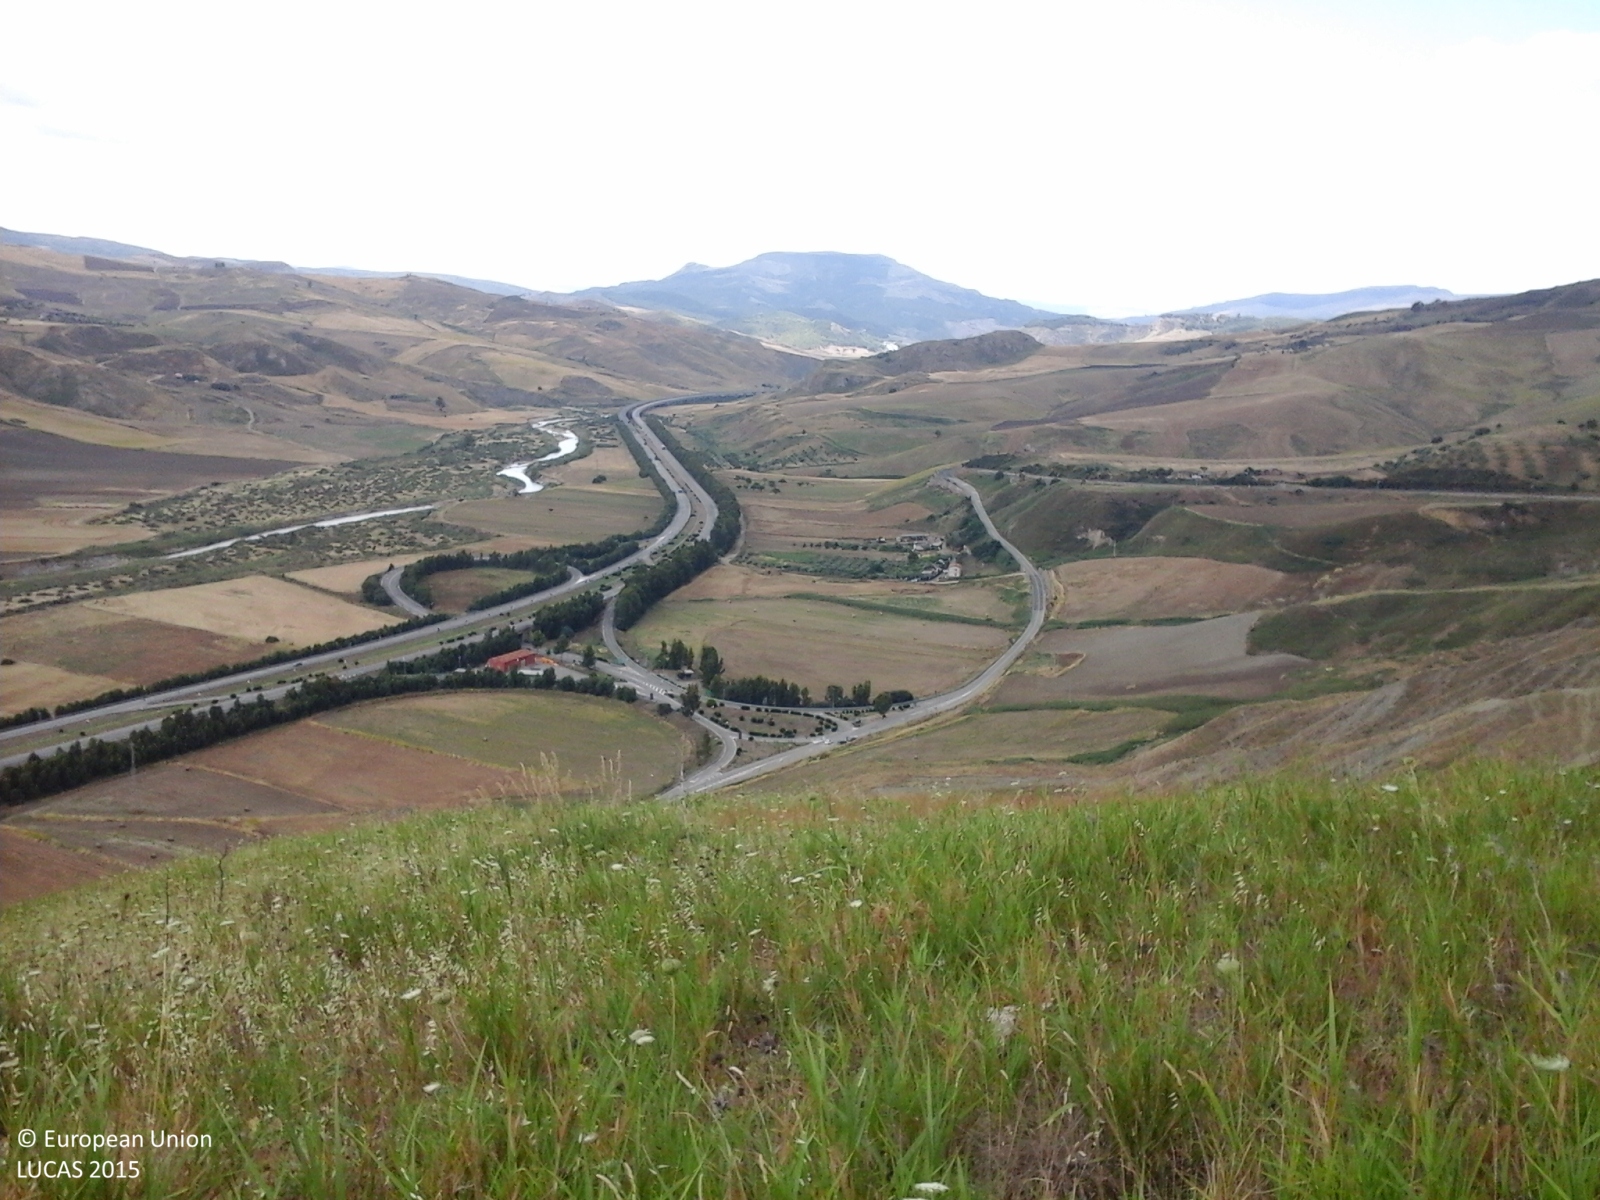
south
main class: Grassland
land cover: Grassland without tree/shrub cover
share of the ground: > 75 %
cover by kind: herbaceous plants 70 %, consolidated bare surface 20 %, unconsolidated bare surface 10 %
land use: Agriculture (excluding fallow land and kitchen gardens)
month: June
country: IT
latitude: 37.6034
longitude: 14.1268
